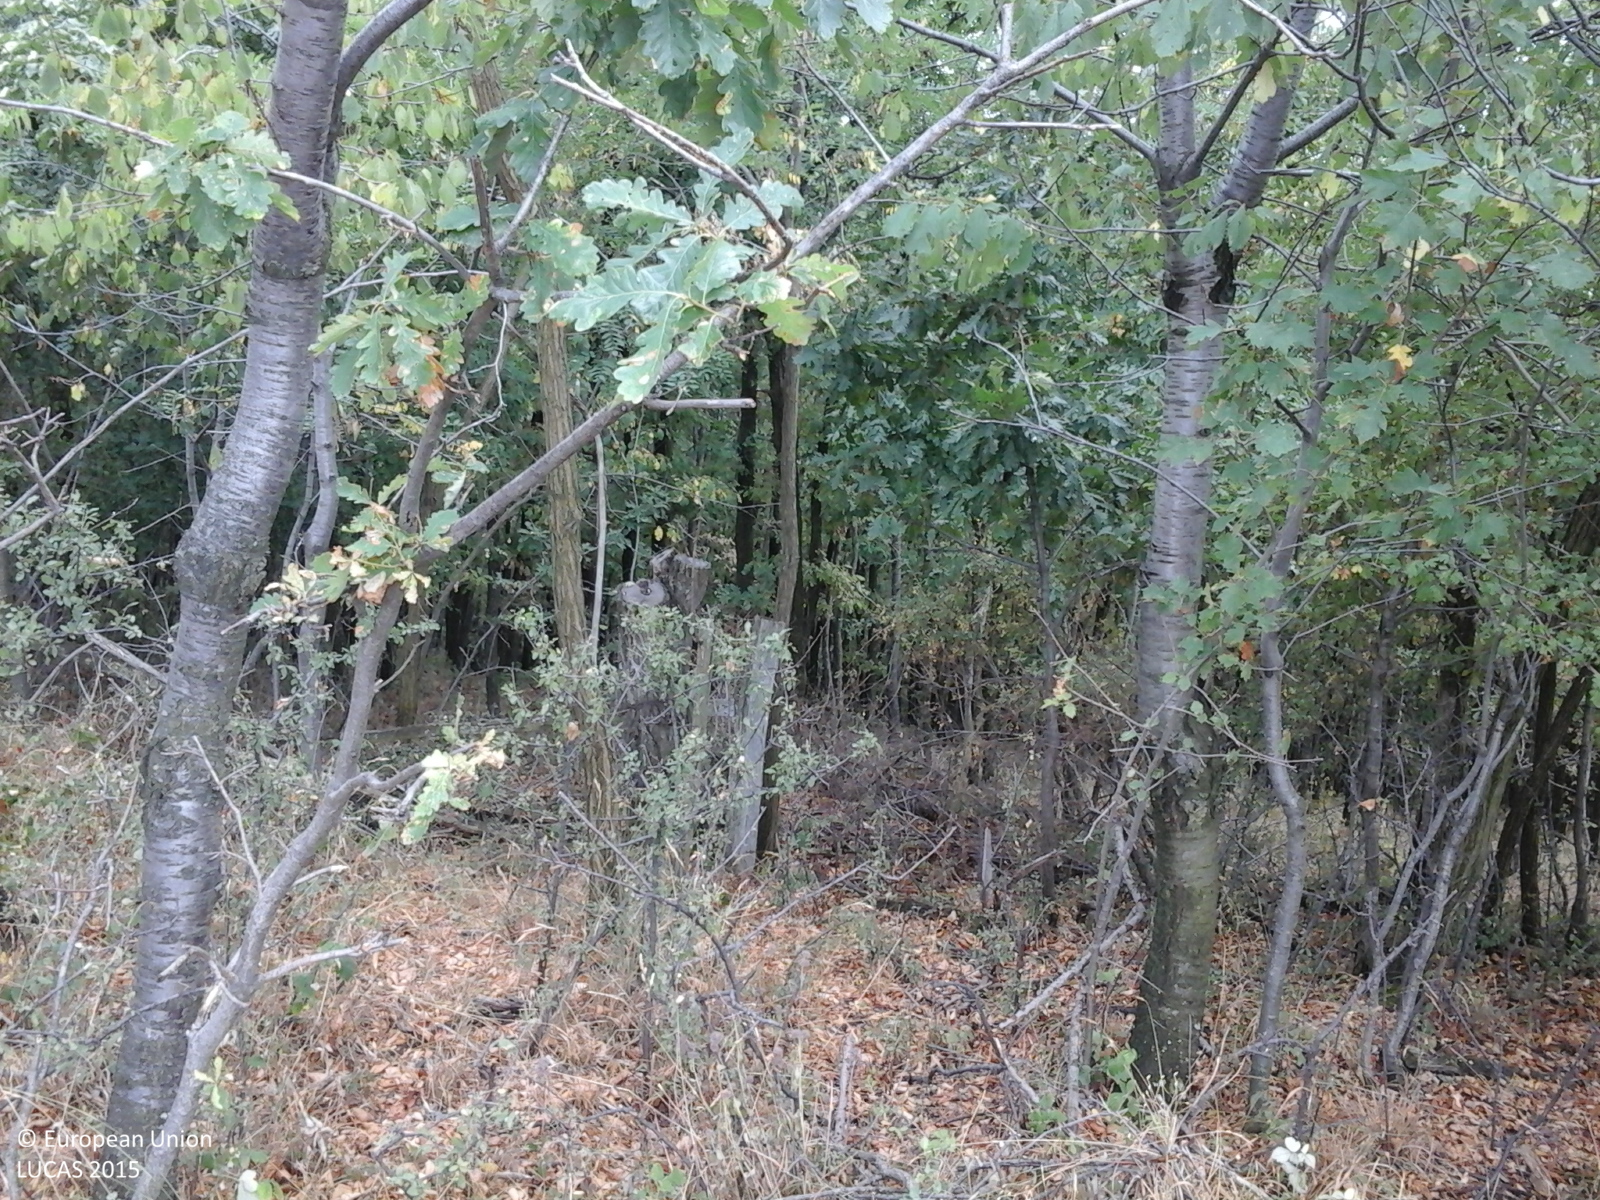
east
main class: Woodland
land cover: Broadleaved woodland
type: acidophilous oak and oak-birch forest
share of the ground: > 75 %
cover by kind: broadleaved forest trees 100 %
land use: Forestry
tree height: > 5 m
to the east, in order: Broadleaved woodland
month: August
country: RO
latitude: 44.7866
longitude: 22.5667
